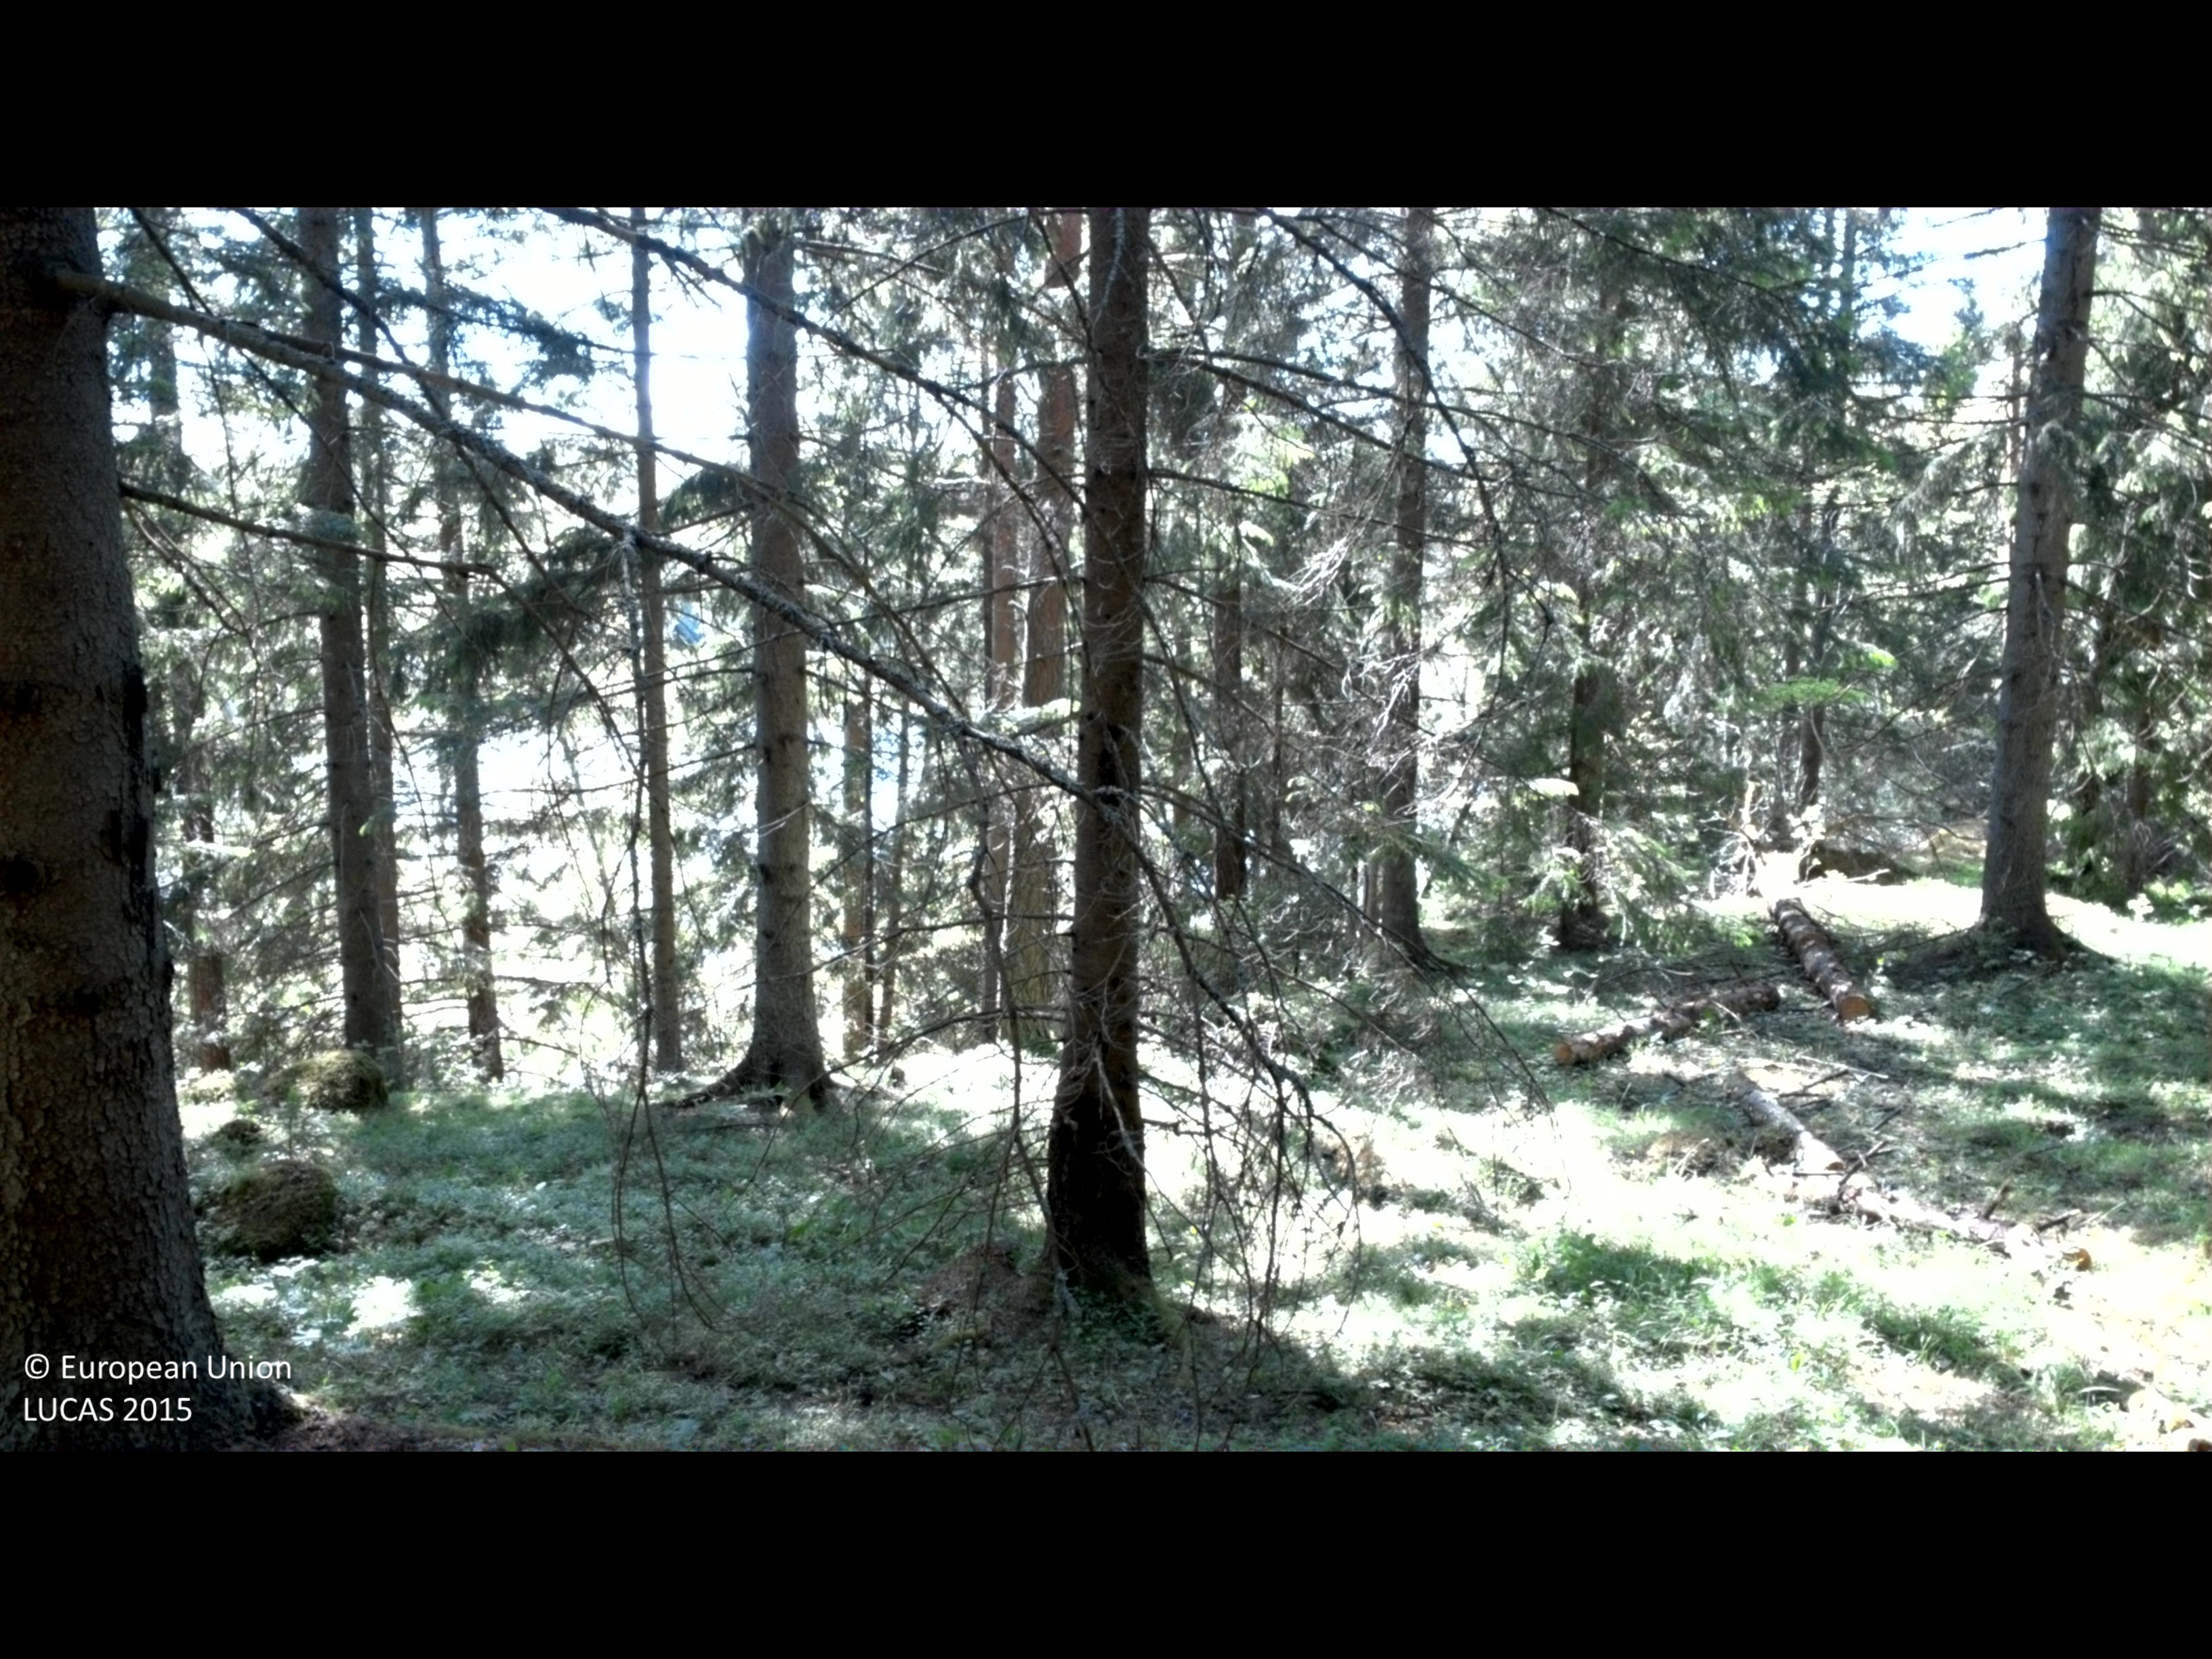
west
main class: Woodland
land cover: Spruce dominated coniferous woodland
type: boreal forest
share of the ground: 50 - 75 %
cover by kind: coniferous forest trees 60 %, herbaceous plants 30 %, shrubs 5 %, lichens and mosses 5 %
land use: Forestry
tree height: > 5 m
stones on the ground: < 10 %
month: June
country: SE
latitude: 57.8218
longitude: 16.2436
